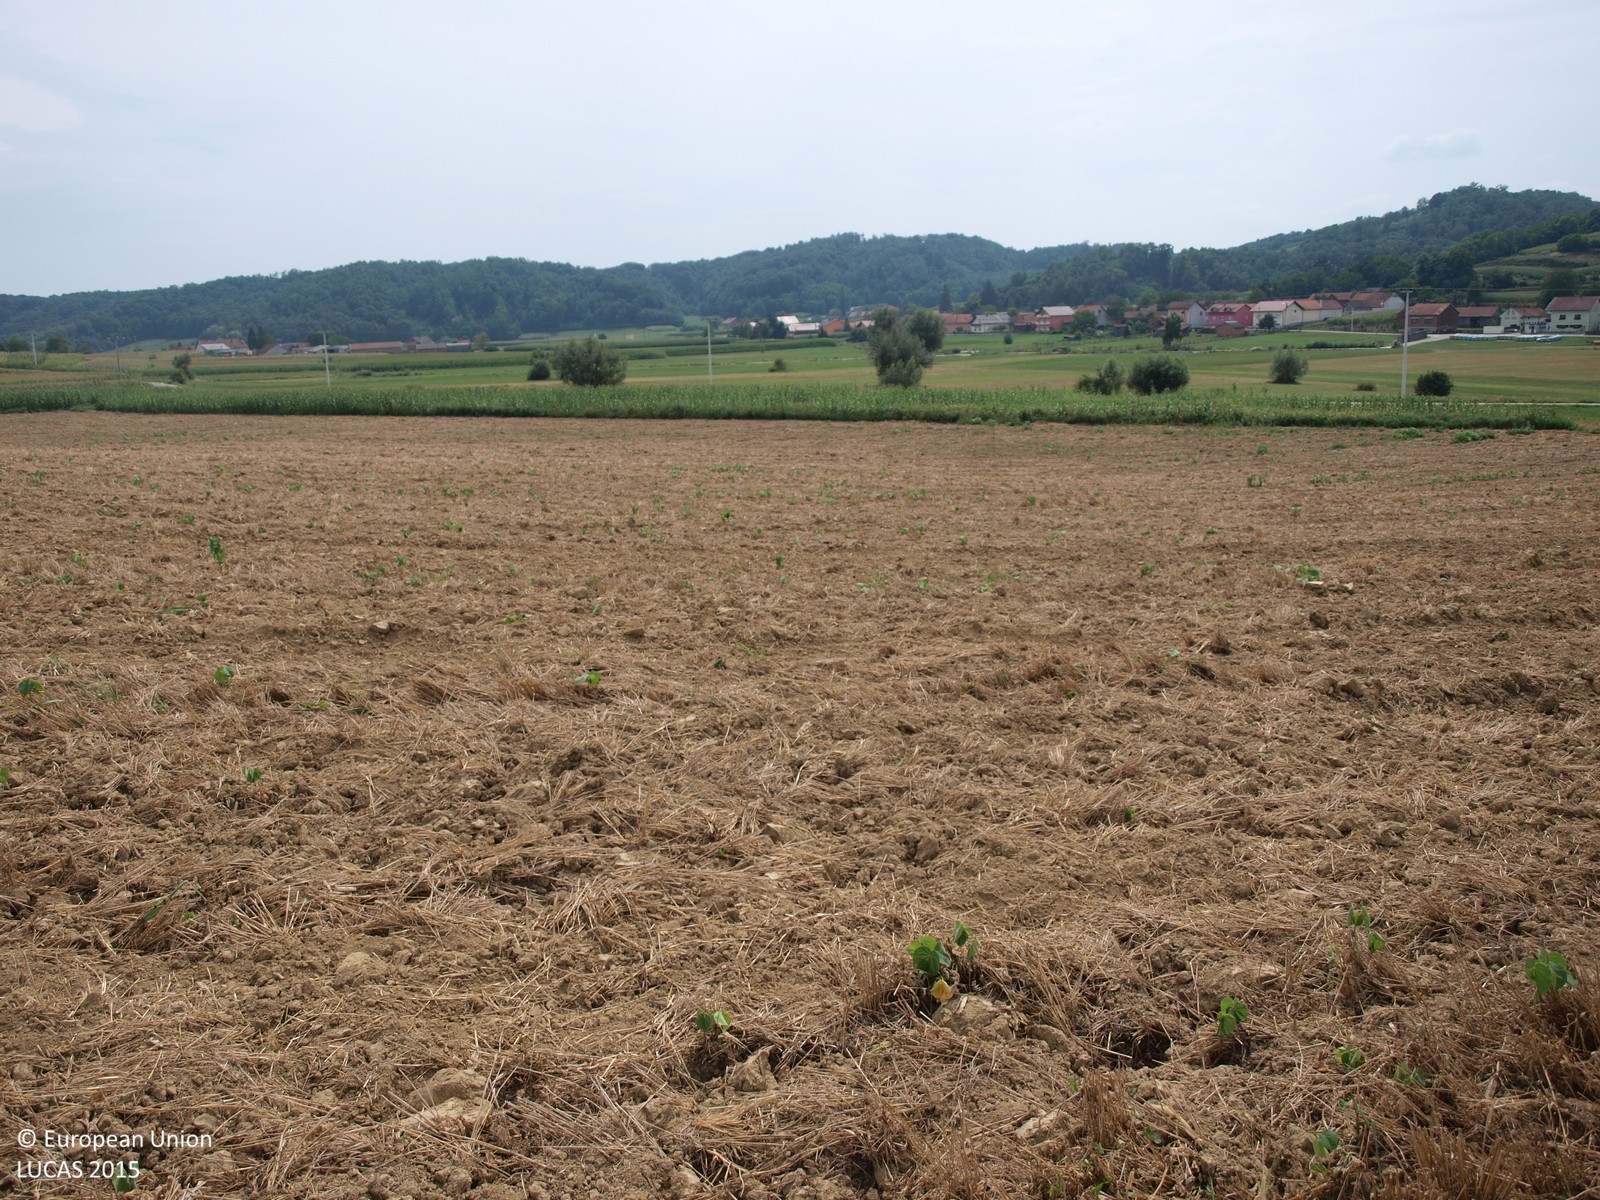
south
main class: Cropland
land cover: Barley
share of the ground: > 75 %
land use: Agriculture (excluding fallow land and kitchen gardens)
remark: Harvested field
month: August
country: HR
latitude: 46.0513
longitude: 16.3971
